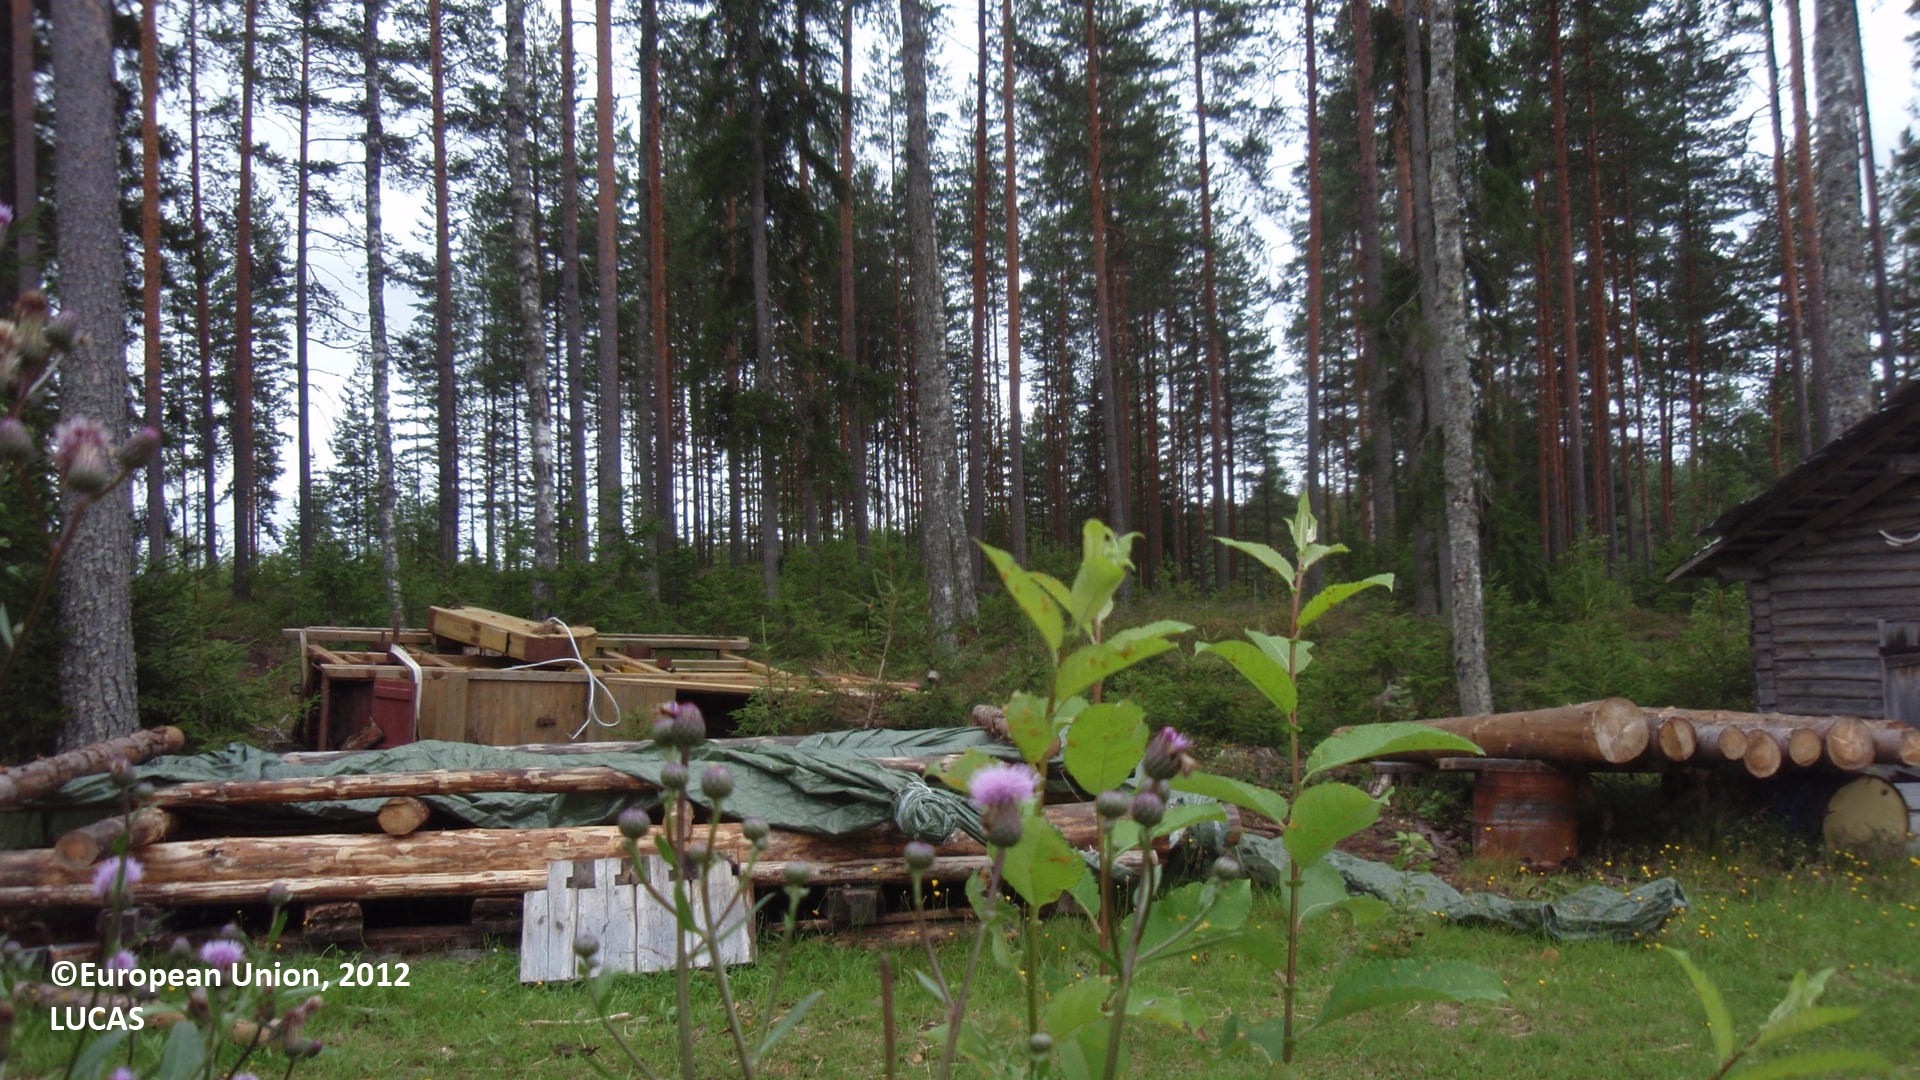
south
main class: Grassland
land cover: Spontaneously vegetated surfaces
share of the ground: > 75 %
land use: Fallow land
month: August
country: FI
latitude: 61.2847
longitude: 27.5905
